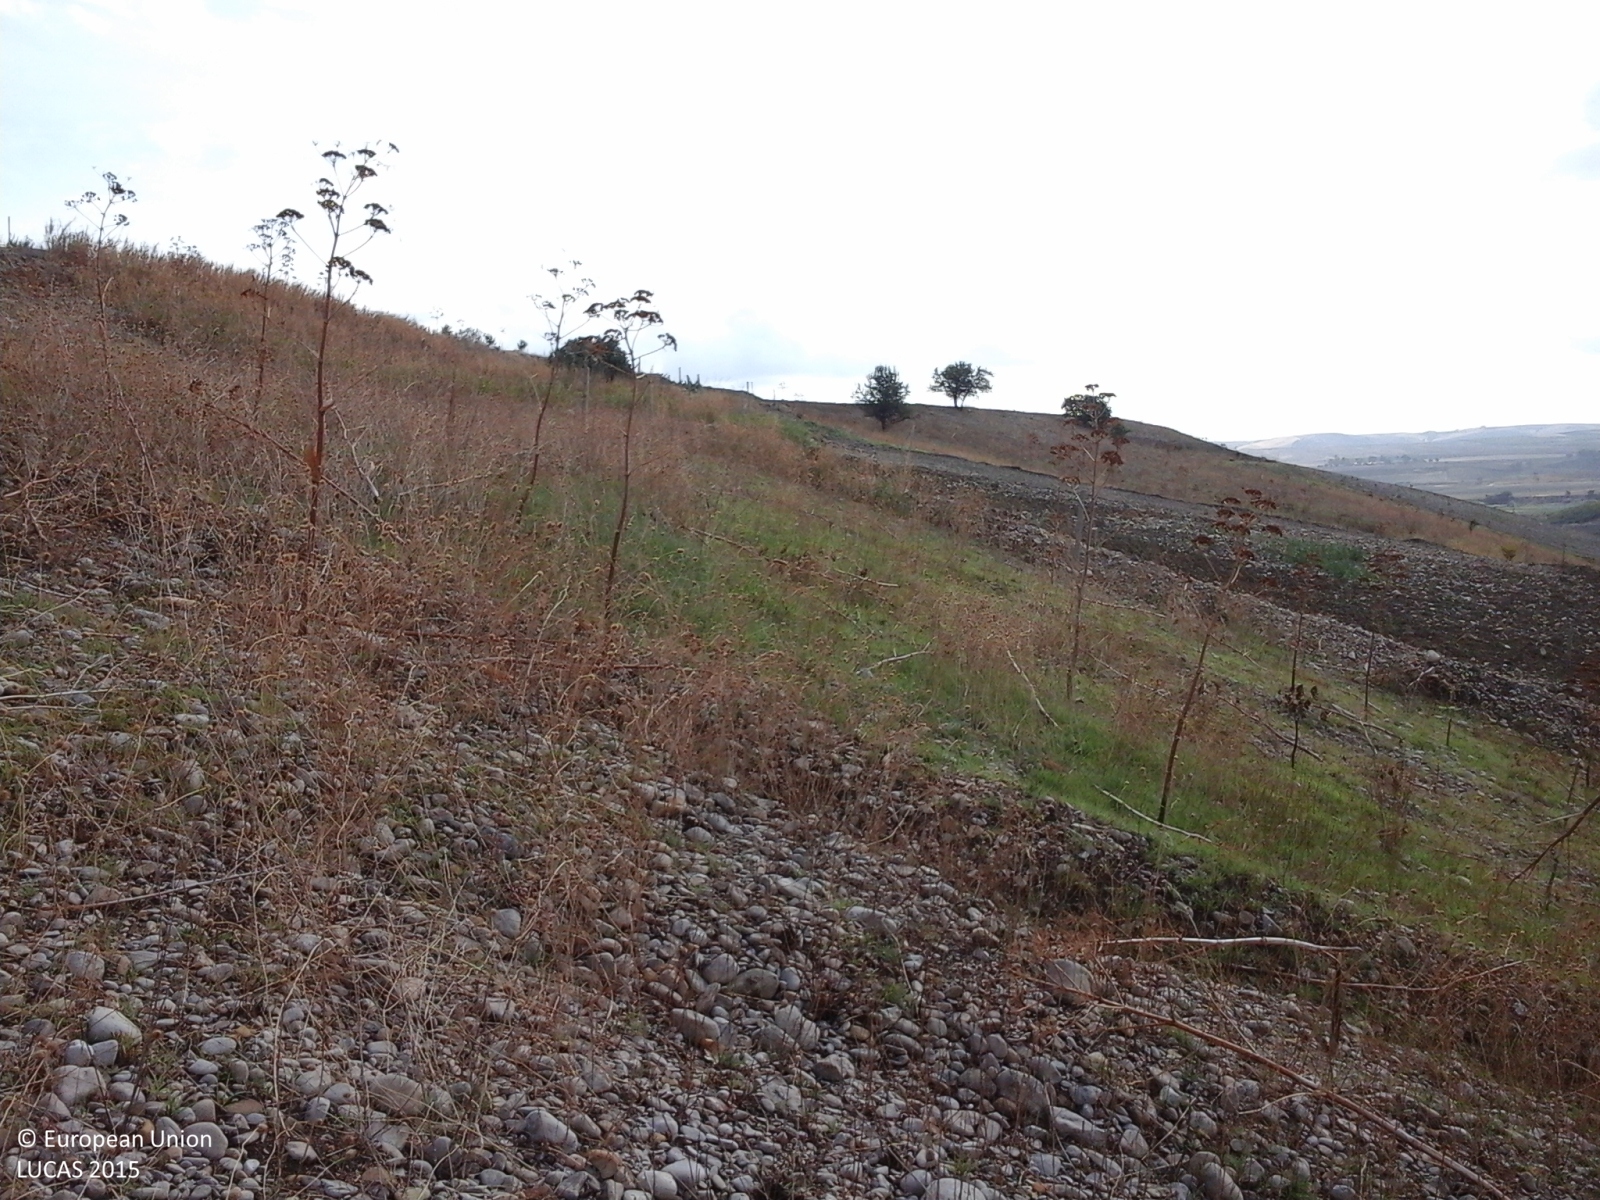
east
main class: Grassland
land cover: Grassland without tree/shrub cover
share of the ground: 50 - 75 %
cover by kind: herbaceous plants 60 %, consolidated bare surface 40 %
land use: Semi-natural and natural areas not in use
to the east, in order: Grassland without tree/shrub cover; Durum wheat
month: September
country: IT
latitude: 41.7259
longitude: 15.1647
